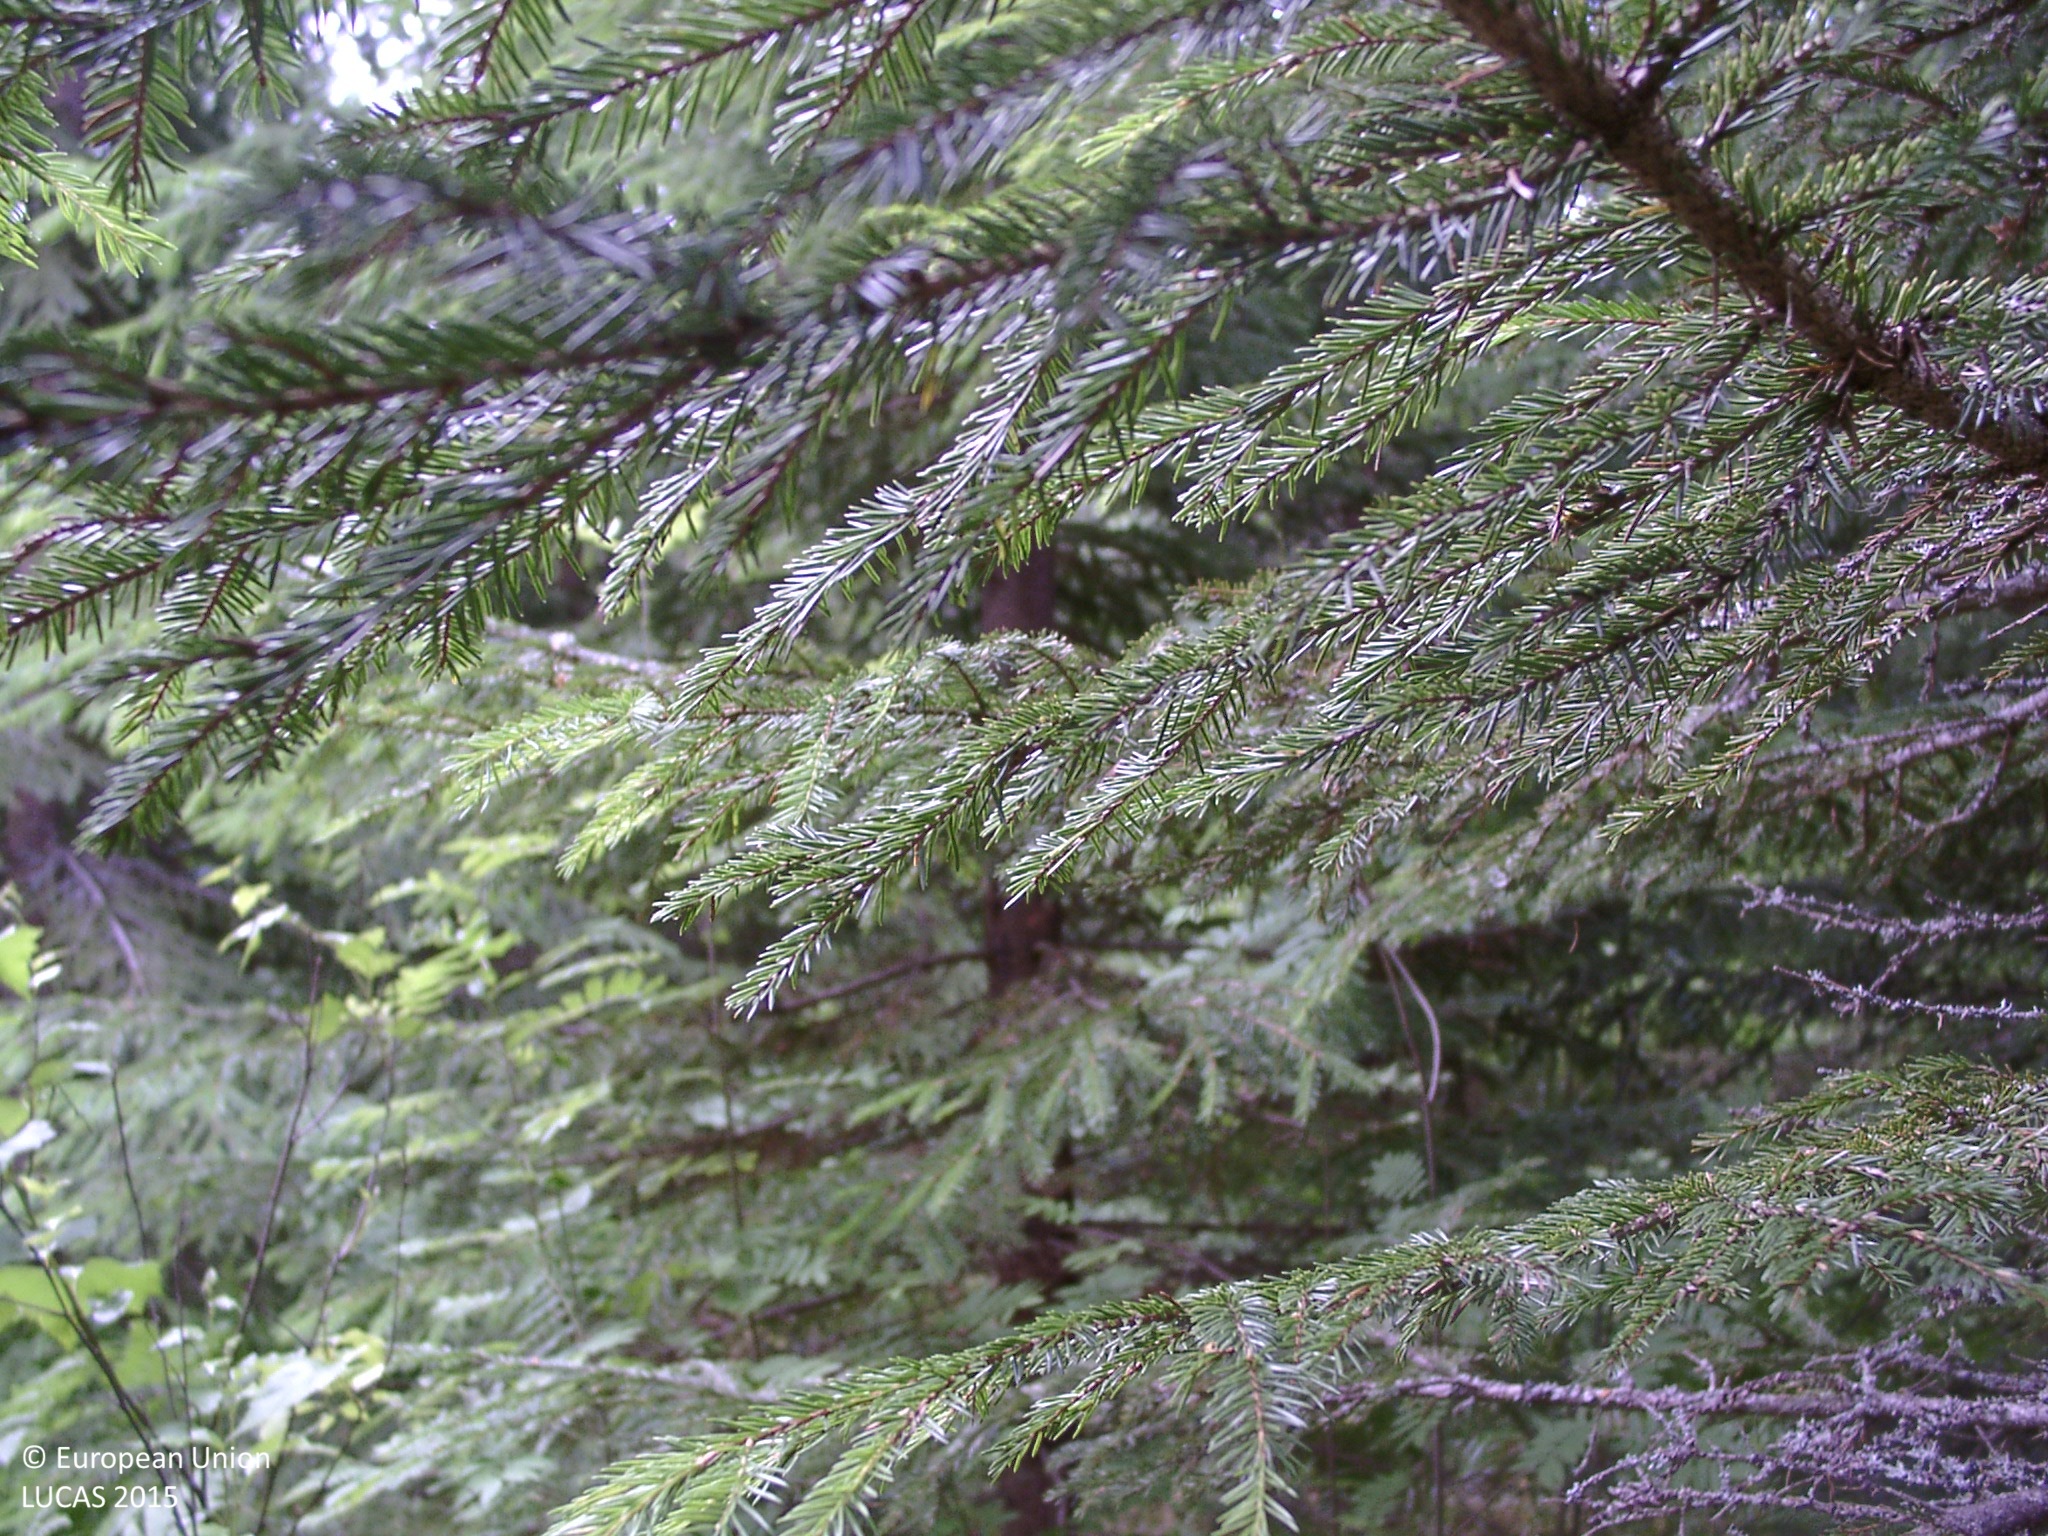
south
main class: Woodland
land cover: Other coniferous woodland
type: boreal forest
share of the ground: > 75 %
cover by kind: coniferous forest trees 80 %, shrubs 10 %, broadleaved forest trees 5 %, lichens and mosses 5 %
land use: Forestry
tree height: > 5 m
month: July
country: FI
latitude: 61.4924
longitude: 25.1191
